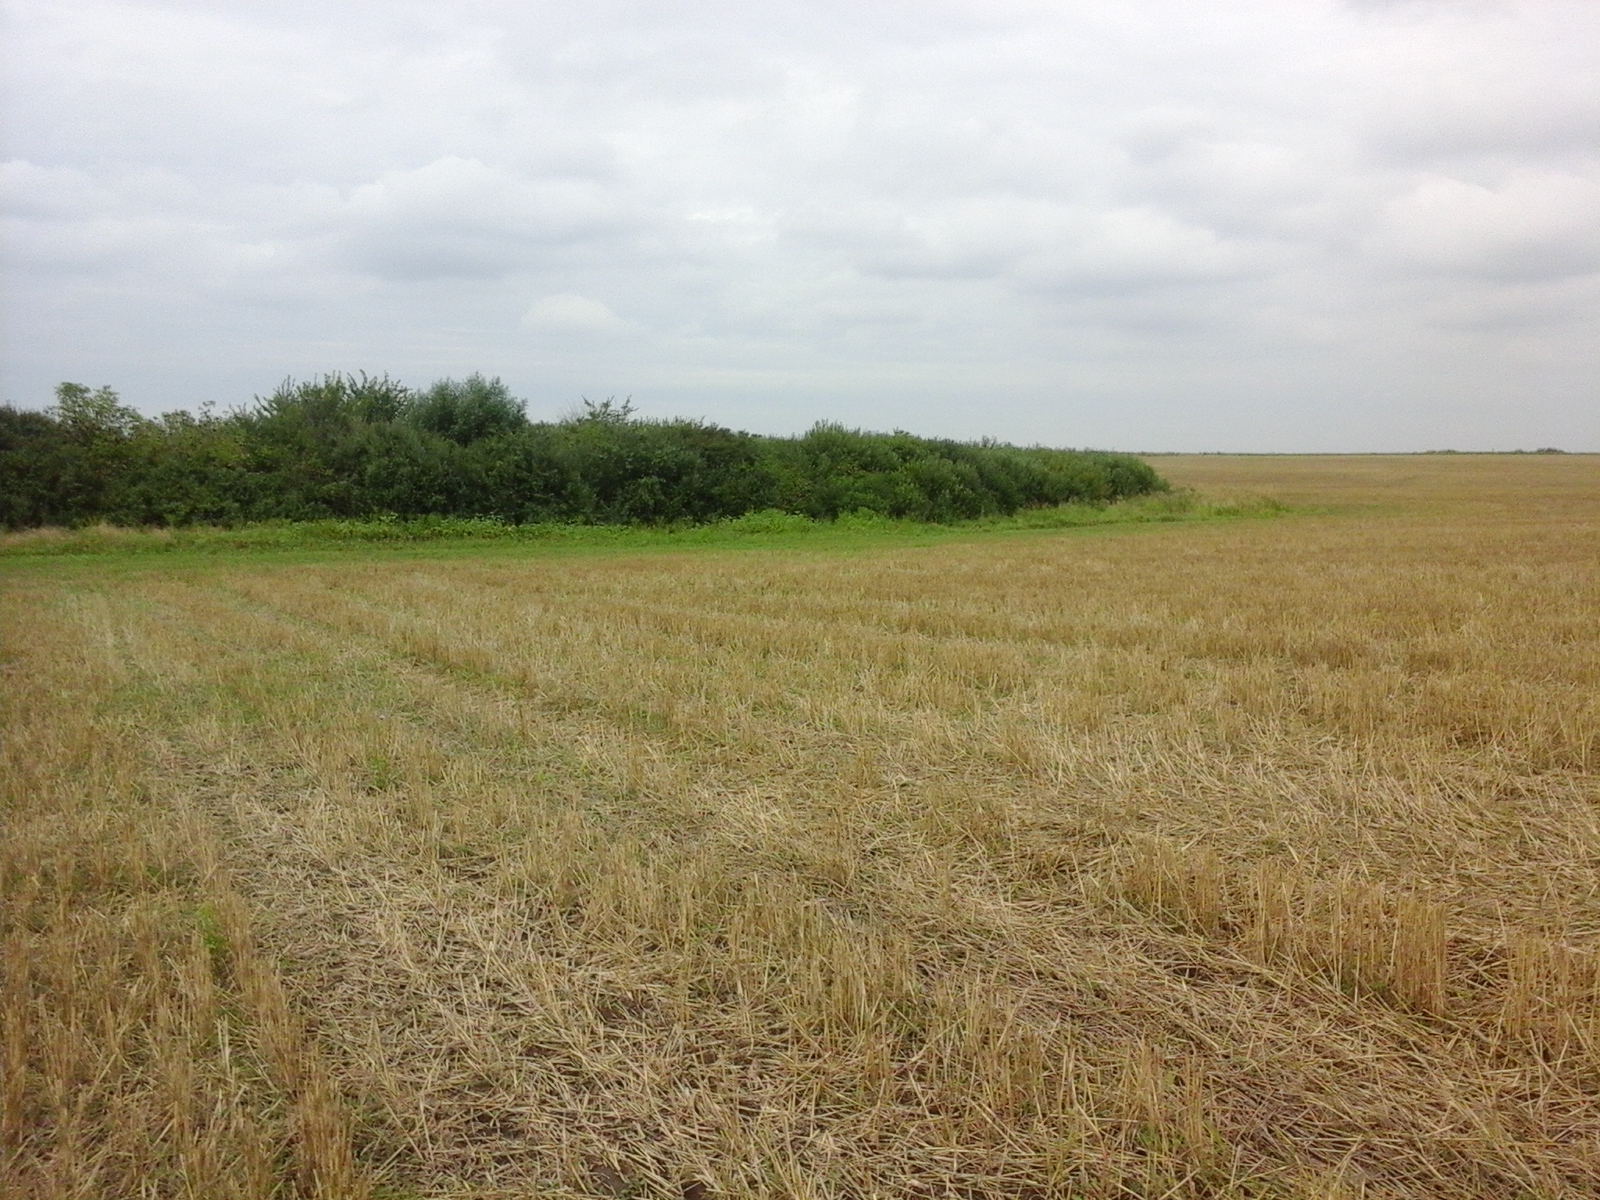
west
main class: Cropland
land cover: Common wheat
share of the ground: 50 - 75 %
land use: Agriculture (excluding fallow land and kitchen gardens)
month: August
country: RO
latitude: 45.5487
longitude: 21.3149
